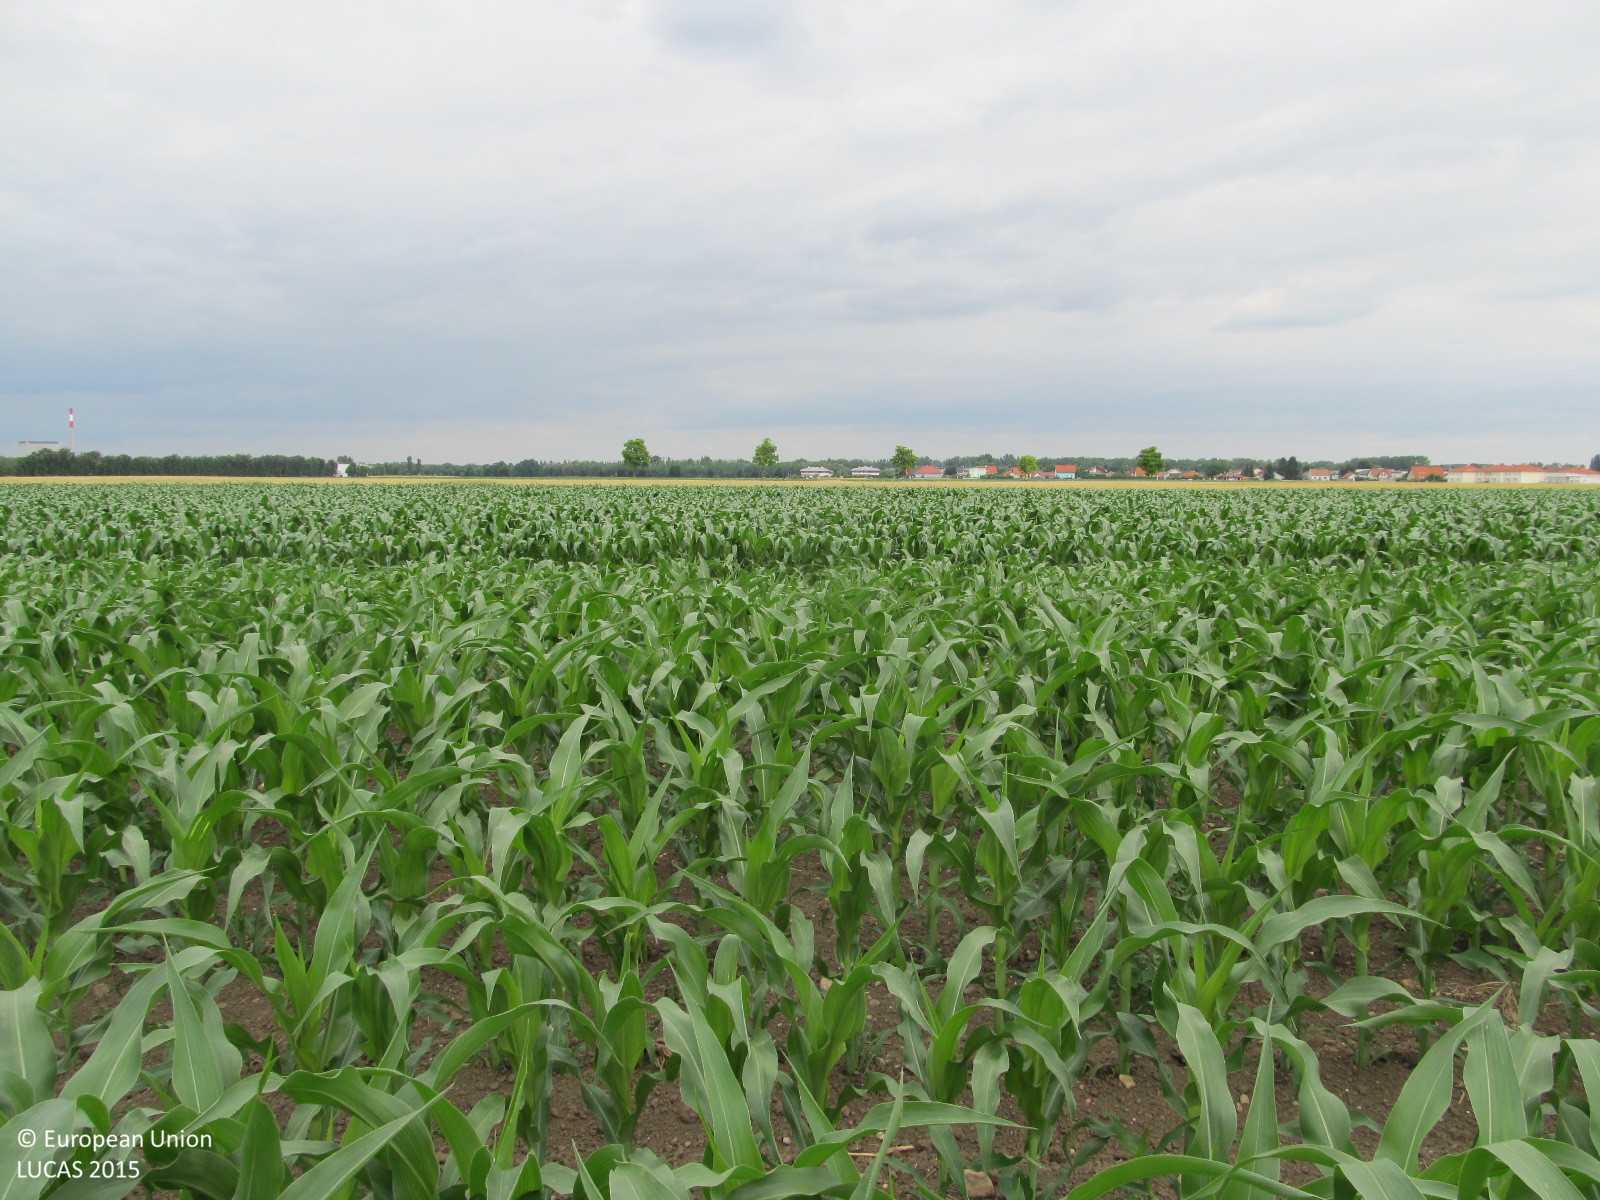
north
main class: Cropland
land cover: Maize
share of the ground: 25 - 50 %
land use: Agriculture (excluding fallow land and kitchen gardens)
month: June
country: AT
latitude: 48.3362
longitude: 15.8989
